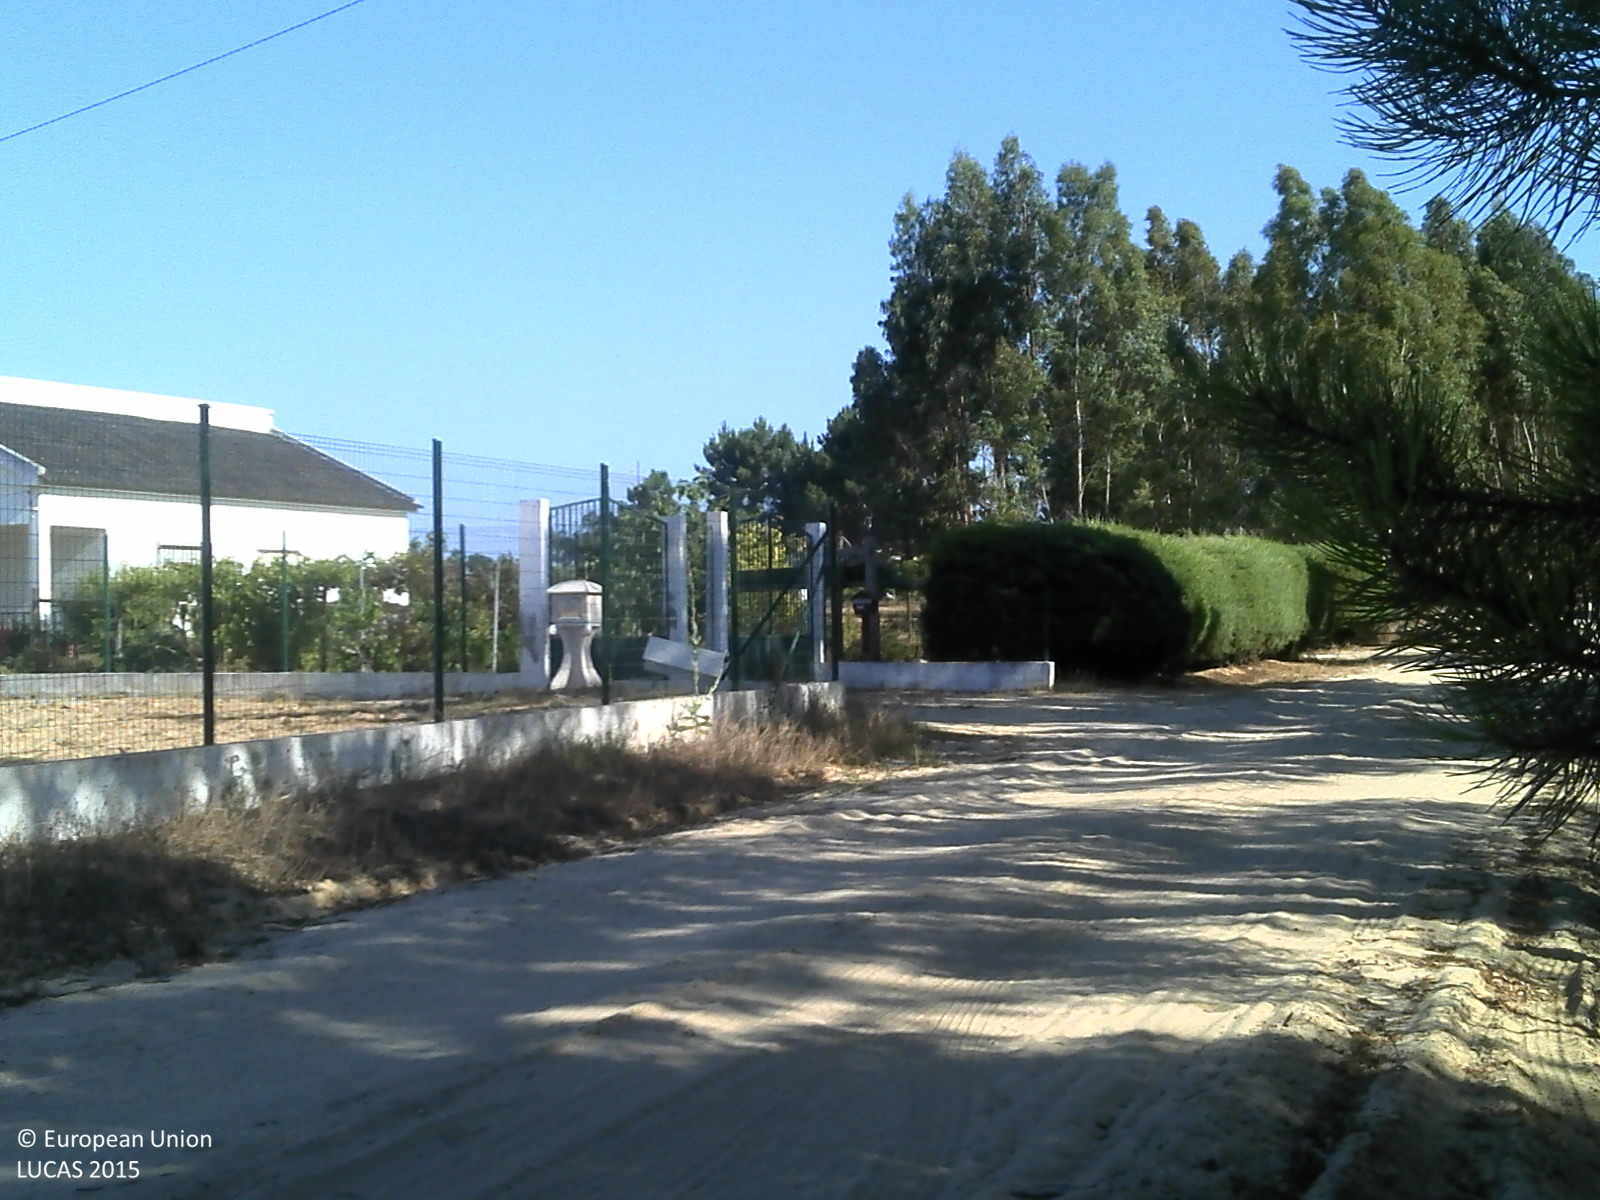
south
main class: Woodland
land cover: Pine dominated coniferous woodland
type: coniferous forest of the mediterranean region
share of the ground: 50 - 75 %
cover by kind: coniferous forest trees 65 %, unconsolidated bare surface 15 %, shrubs 10 %, broadleaved forest trees 5 %, herbaceous plants 5 %
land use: Forestry
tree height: > 5 m
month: July
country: PT
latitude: 38.9682
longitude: -8.6126
